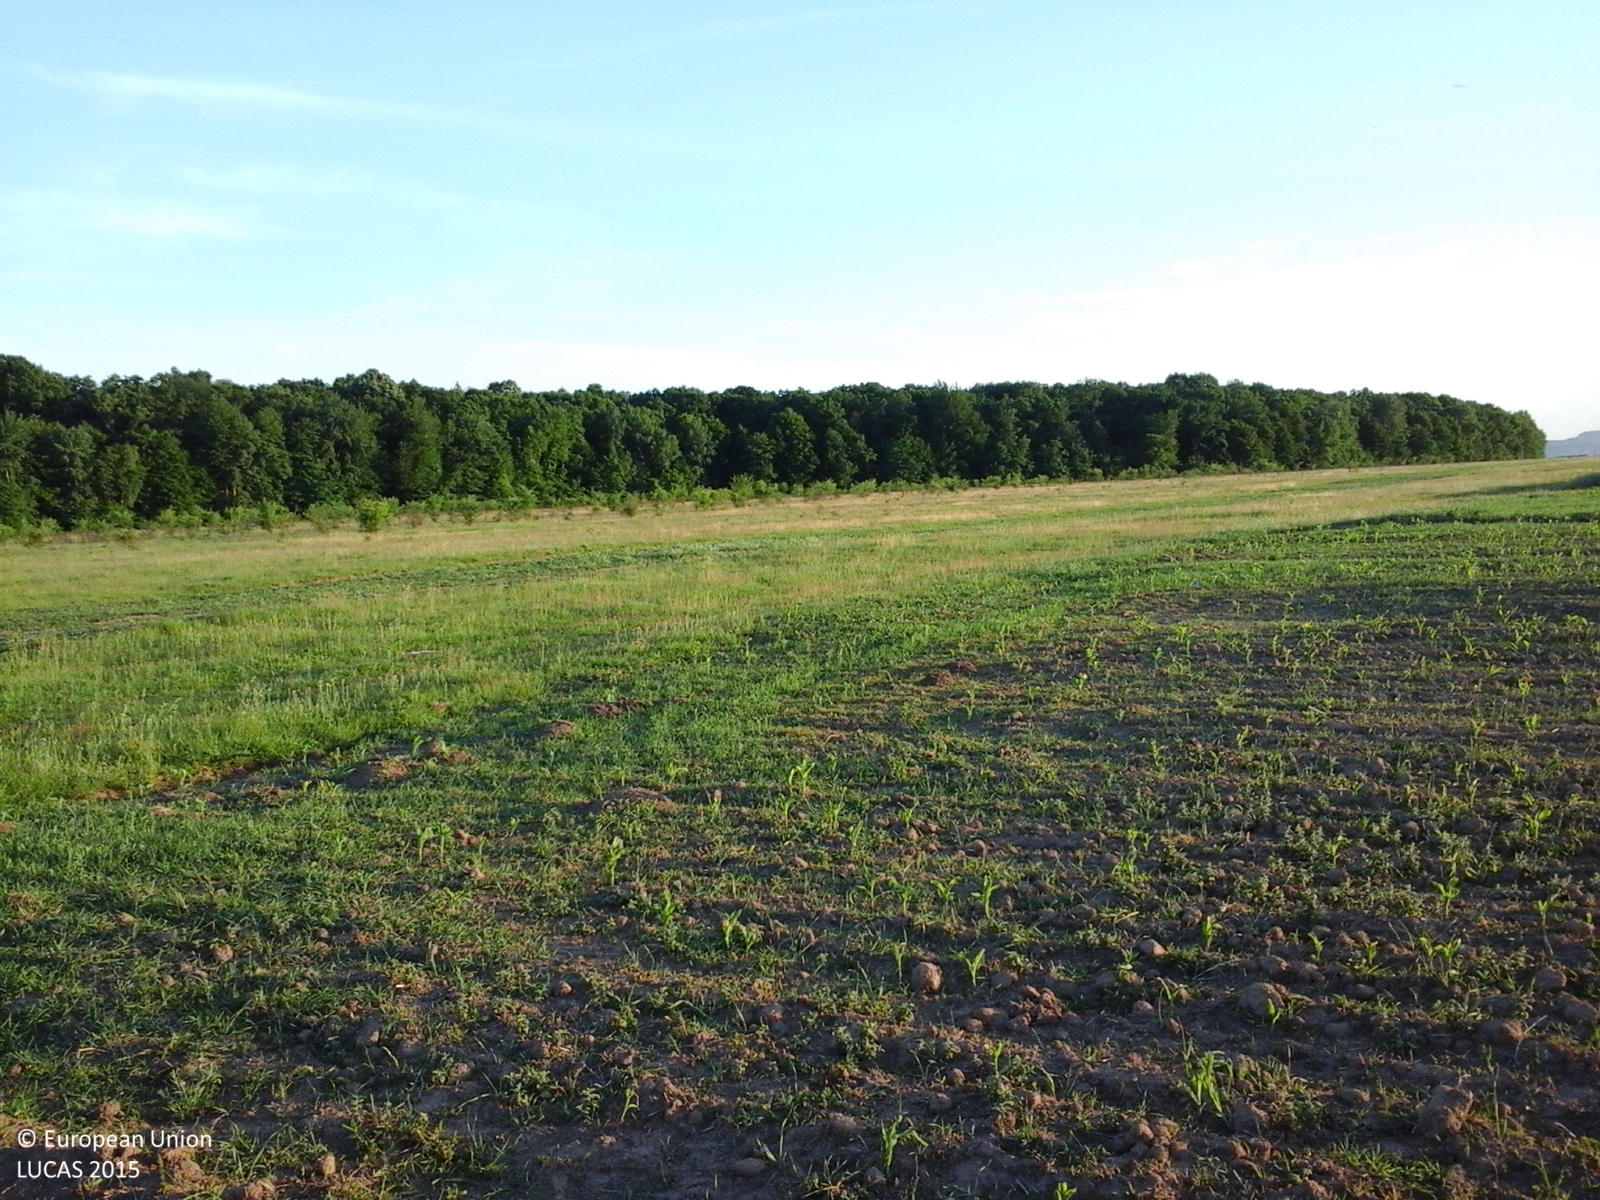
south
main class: Grassland
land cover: Grassland without tree/shrub cover
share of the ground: > 75 %
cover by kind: herbaceous plants 100 %
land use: Agriculture (excluding fallow land and kitchen gardens)
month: June
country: RO
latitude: 45.0732
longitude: 25.8169
